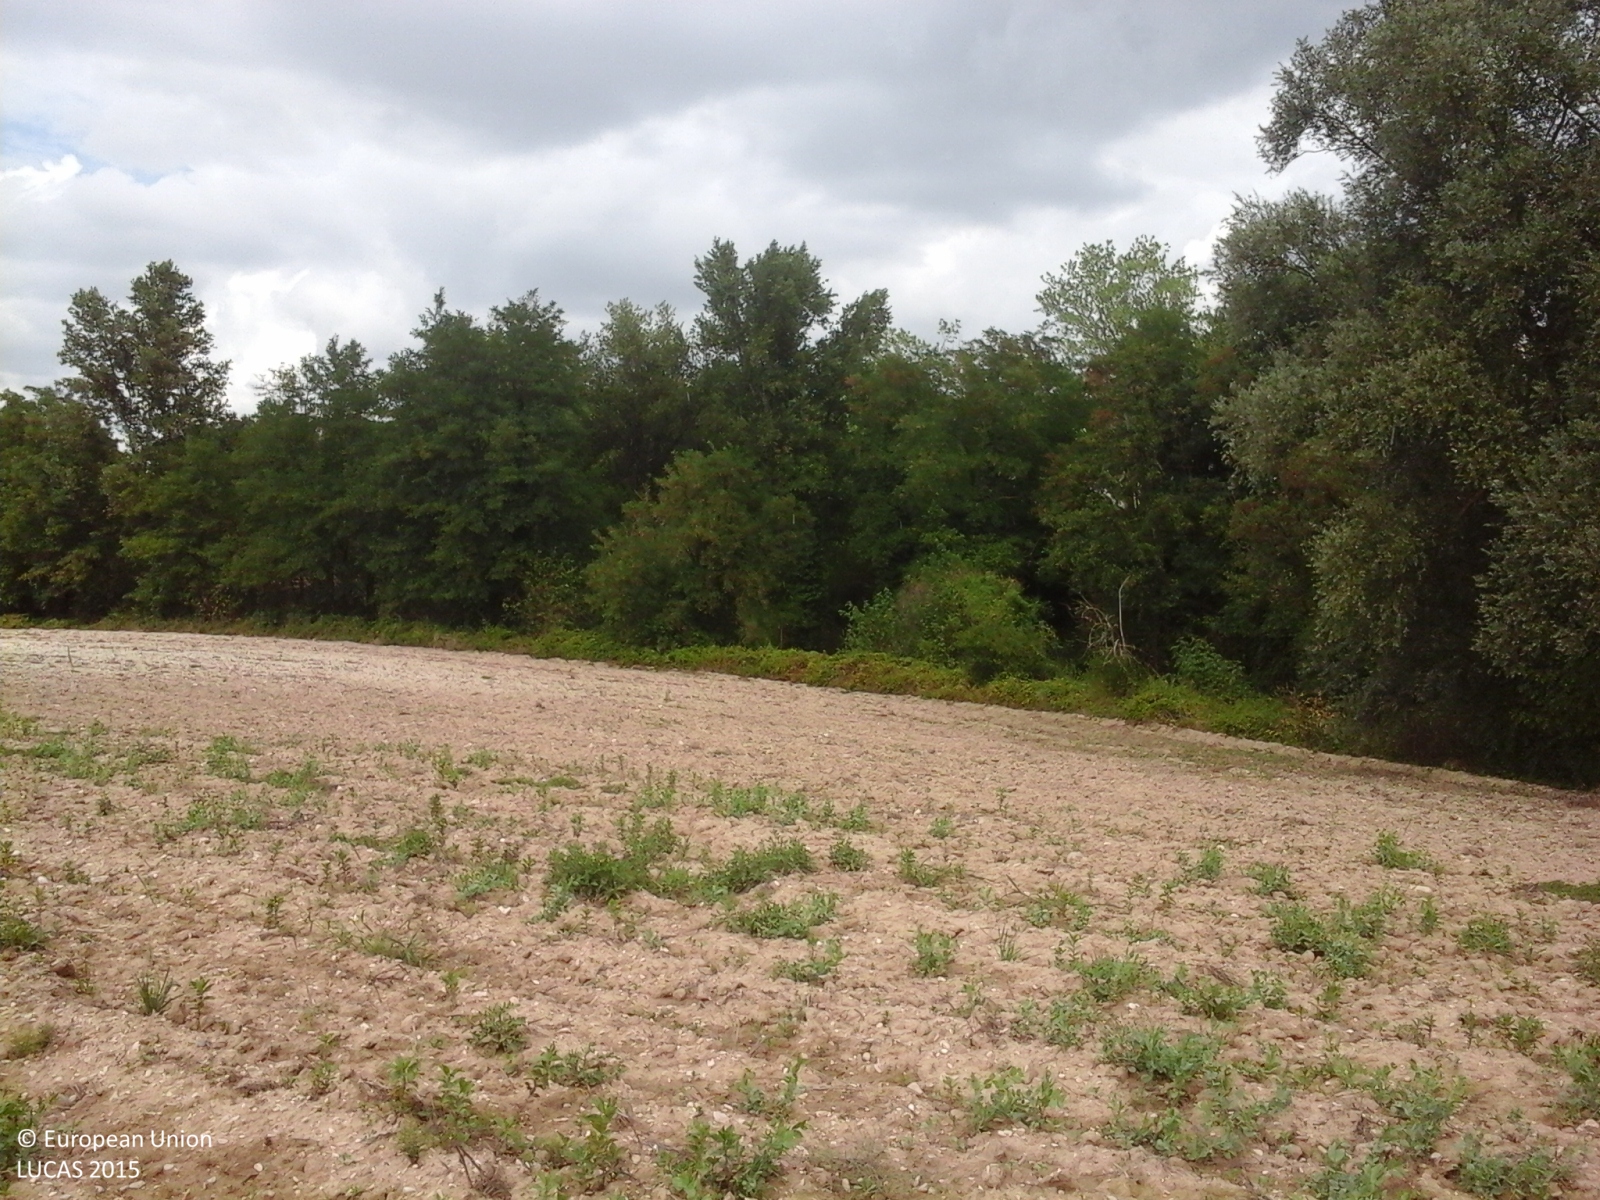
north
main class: Cropland
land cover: Dry pulses
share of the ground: < 10 %
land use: Agriculture (excluding fallow land and kitchen gardens)
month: August
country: IT
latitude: 43.4505
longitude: 13.2665
